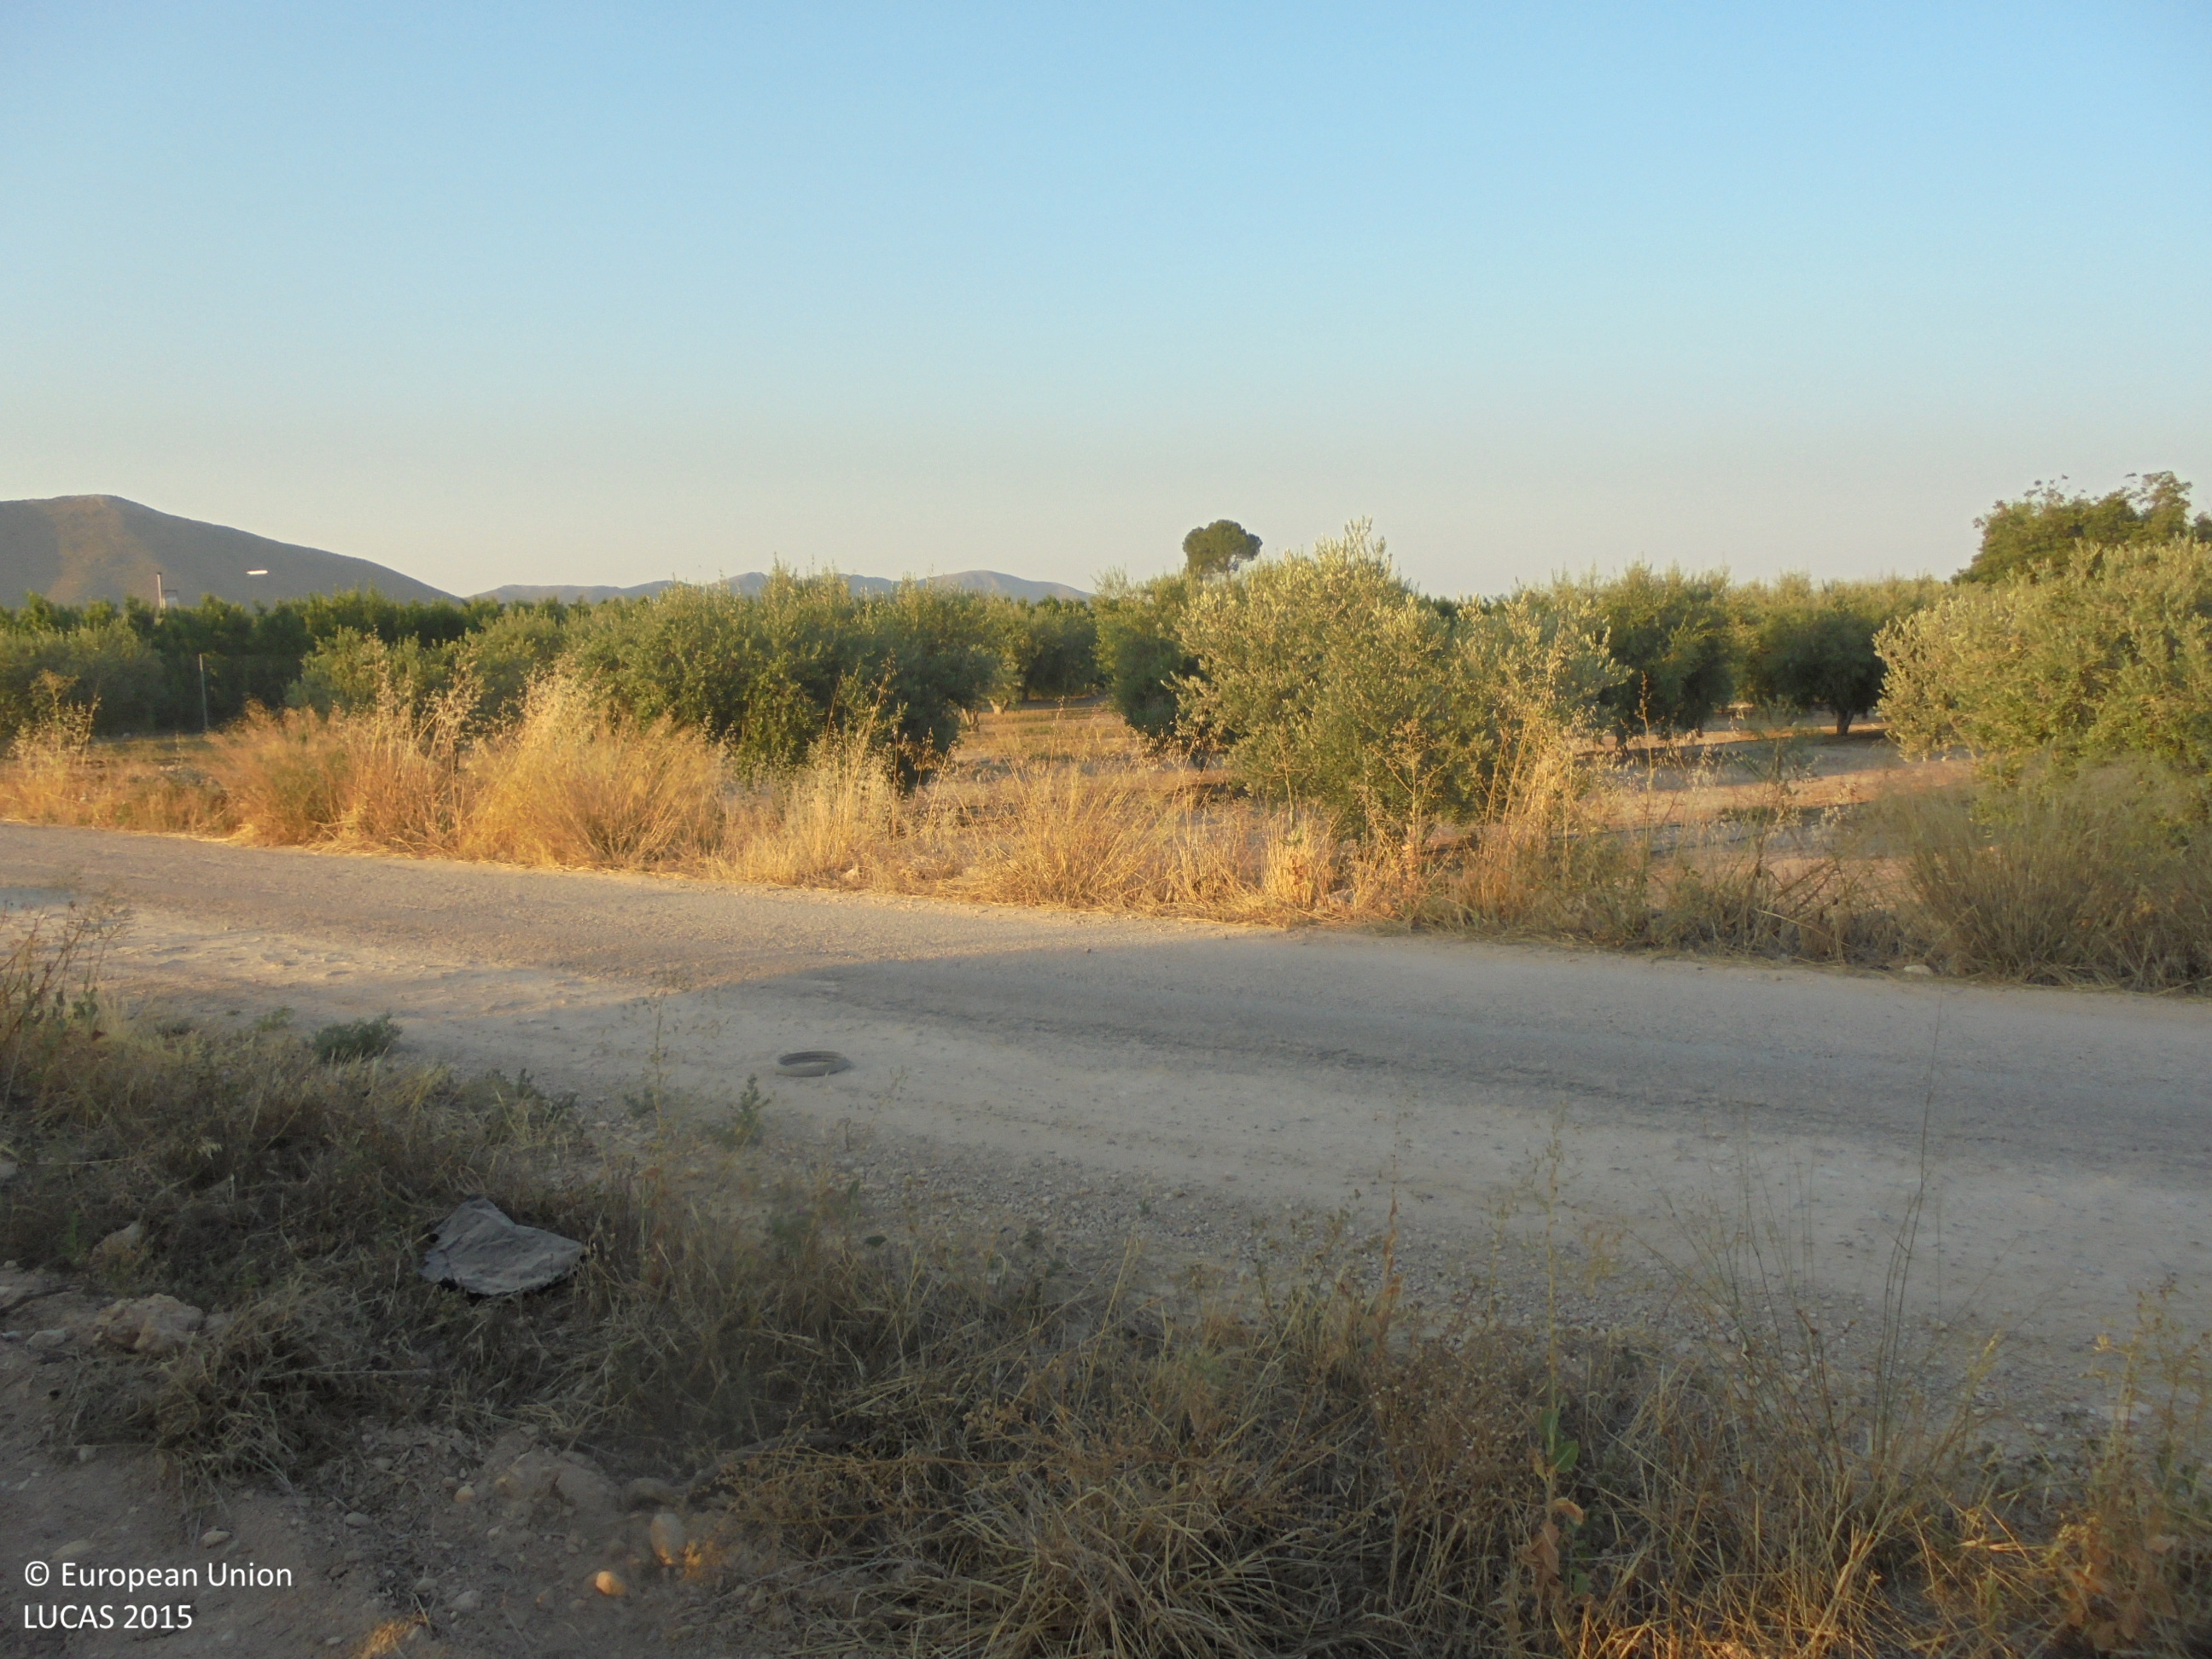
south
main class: Cropland
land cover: Olive groves
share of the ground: 25 - 50 %
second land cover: Other bare soil
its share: > 75 %
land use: Agriculture (excluding fallow land and kitchen gardens)
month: July
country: ES
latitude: 38.5817
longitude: -1.6686
